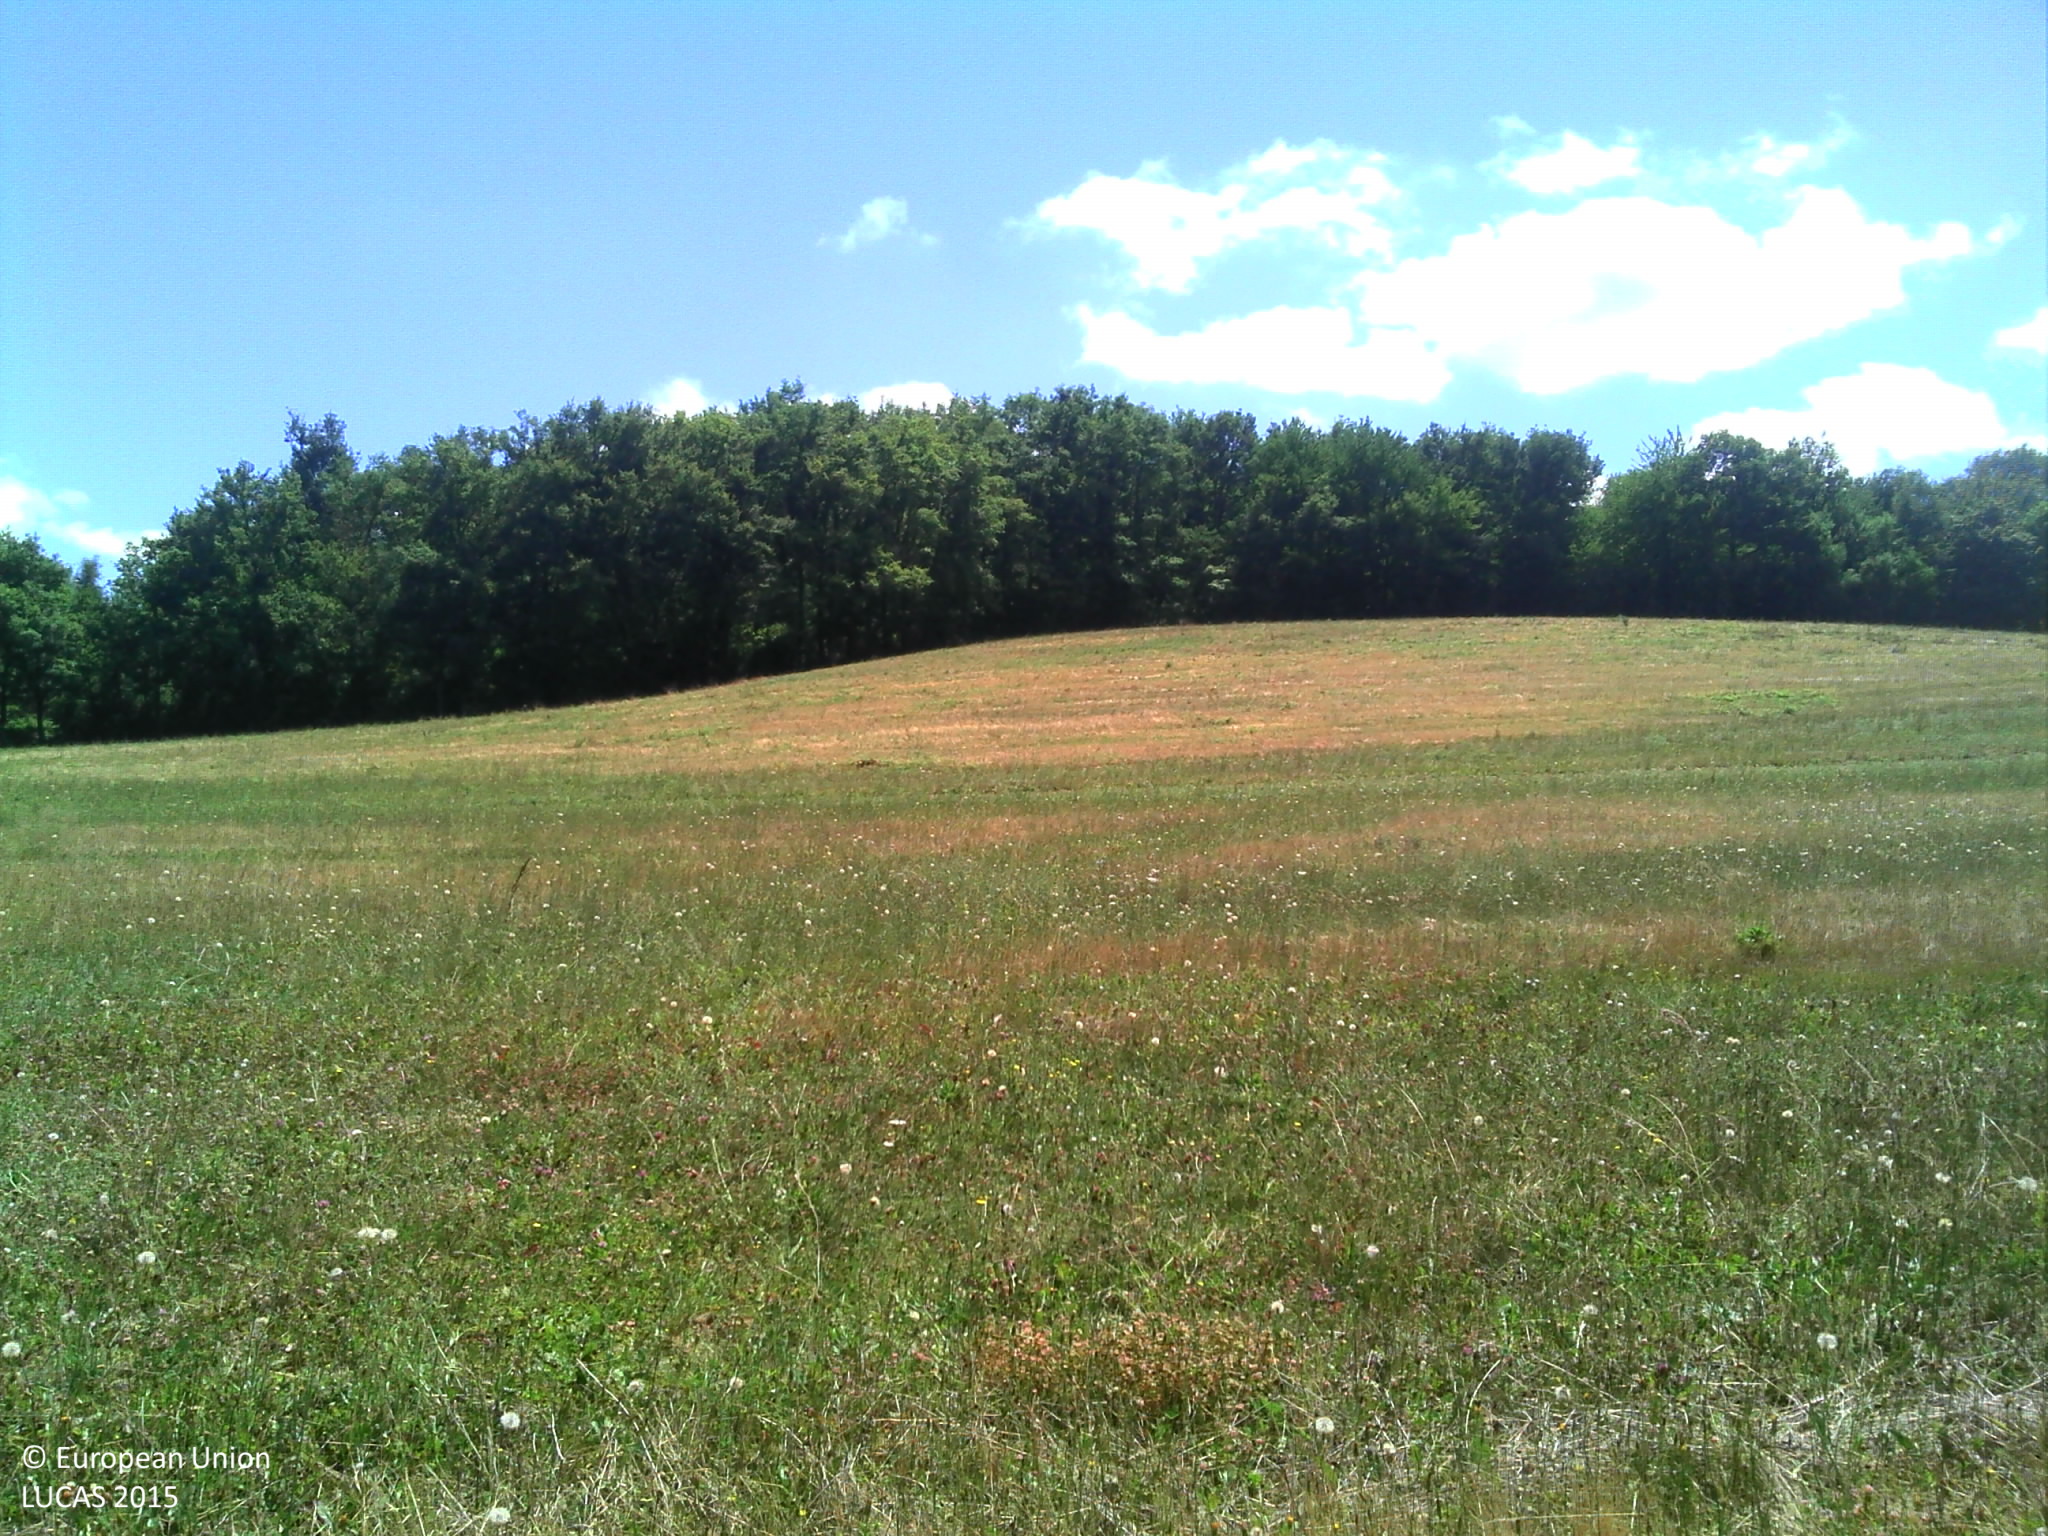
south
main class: Grassland
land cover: Grassland without tree/shrub cover
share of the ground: > 75 %
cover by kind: herbaceous plants 100 %
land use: Agriculture (excluding fallow land and kitchen gardens)
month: July
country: FR
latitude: 43.2471
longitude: 0.7517
